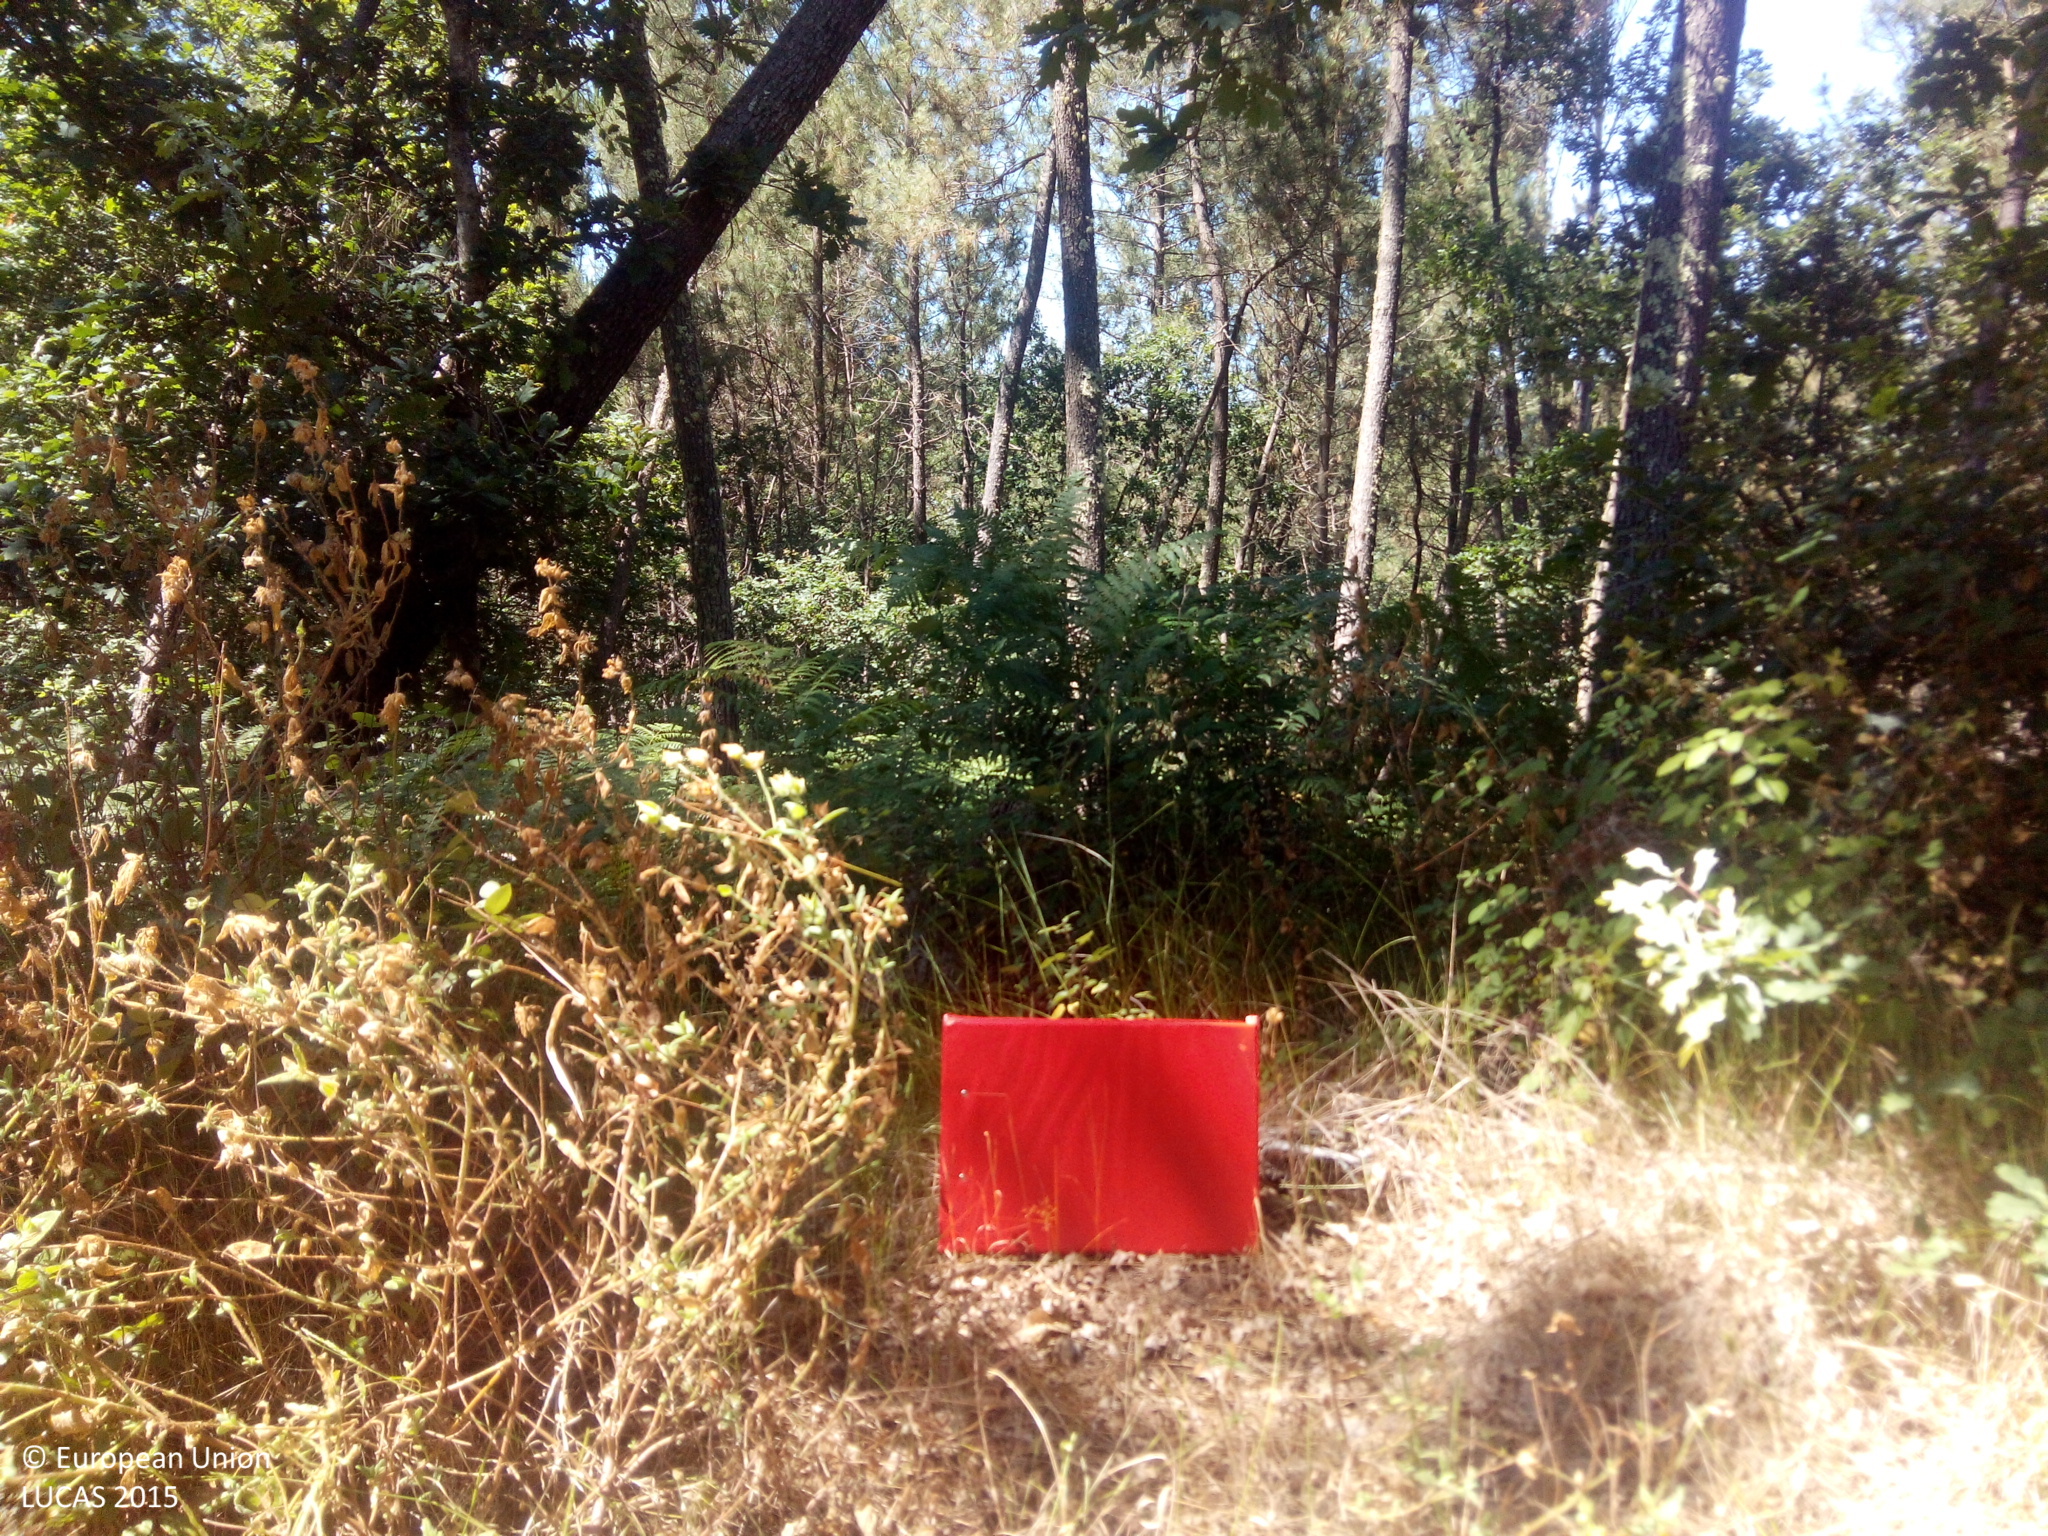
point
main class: Woodland
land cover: Pine dominated mixed woodland
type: hemiboreal forest and nemoral coniferous forest and mixed broadleaved-coniferous forest
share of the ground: > 75 %
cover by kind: coniferous forest trees 75 %, broadleaved forest trees 25 %
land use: Forestry
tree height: > 5 m
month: June
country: ES
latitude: 42.7586
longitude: -8.4154
